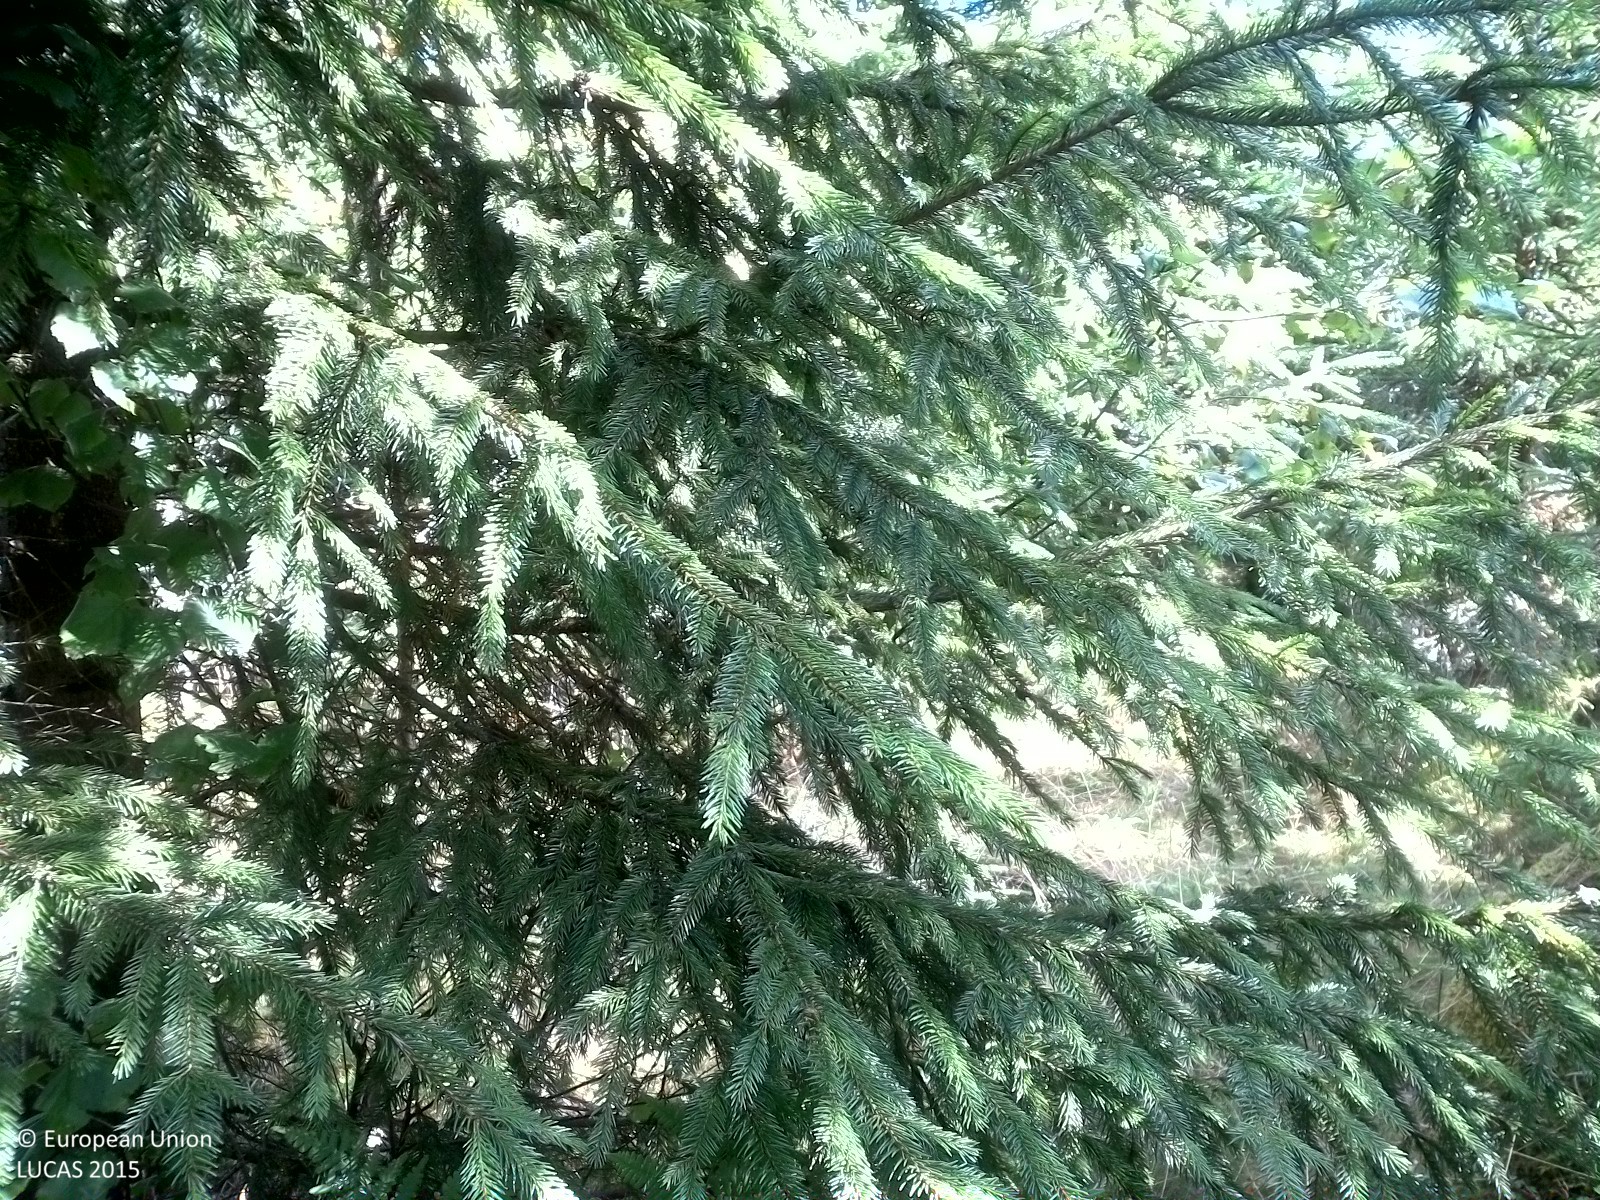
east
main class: Woodland
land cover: Spruce dominated mixed woodland
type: boreal forest
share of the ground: 50 - 75 %
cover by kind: coniferous forest trees 40 %, broadleaved forest trees 30 %, herbaceous plants 20 %, lichens and mosses 10 %
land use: Forestry
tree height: < 5 m
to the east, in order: Spruce dominated mixed woodland; Rock outcrops; Spruce dominated mixed woodland; Rivers and streams; Spontaneously vegetated surfaces
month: August
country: SE
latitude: 58.6132
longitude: 15.0029
